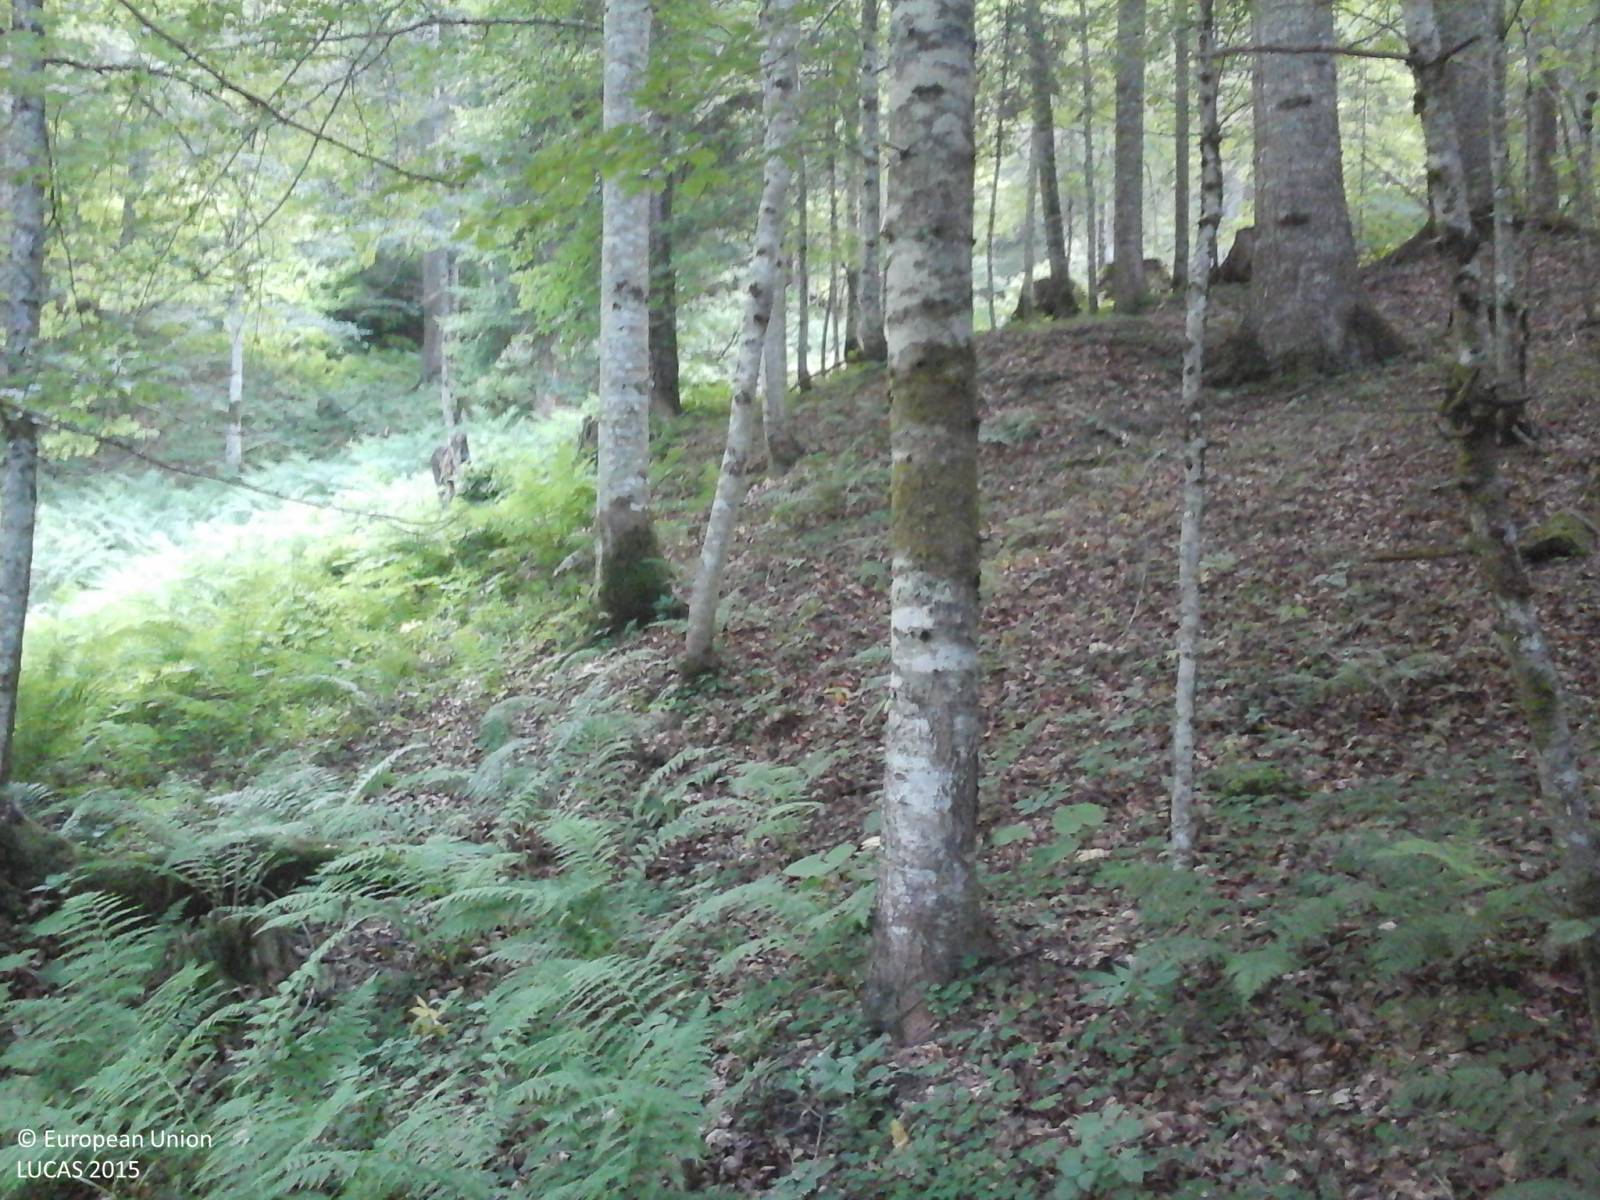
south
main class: Woodland
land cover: Spruce dominated mixed woodland
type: alpine coniferous forest
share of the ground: > 75 %
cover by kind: coniferous forest trees 65 %, broadleaved forest trees 30 %, herbaceous plants 5 %
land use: Forestry
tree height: > 5 m
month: July
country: IT
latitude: 46.4428
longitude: 12.7176
